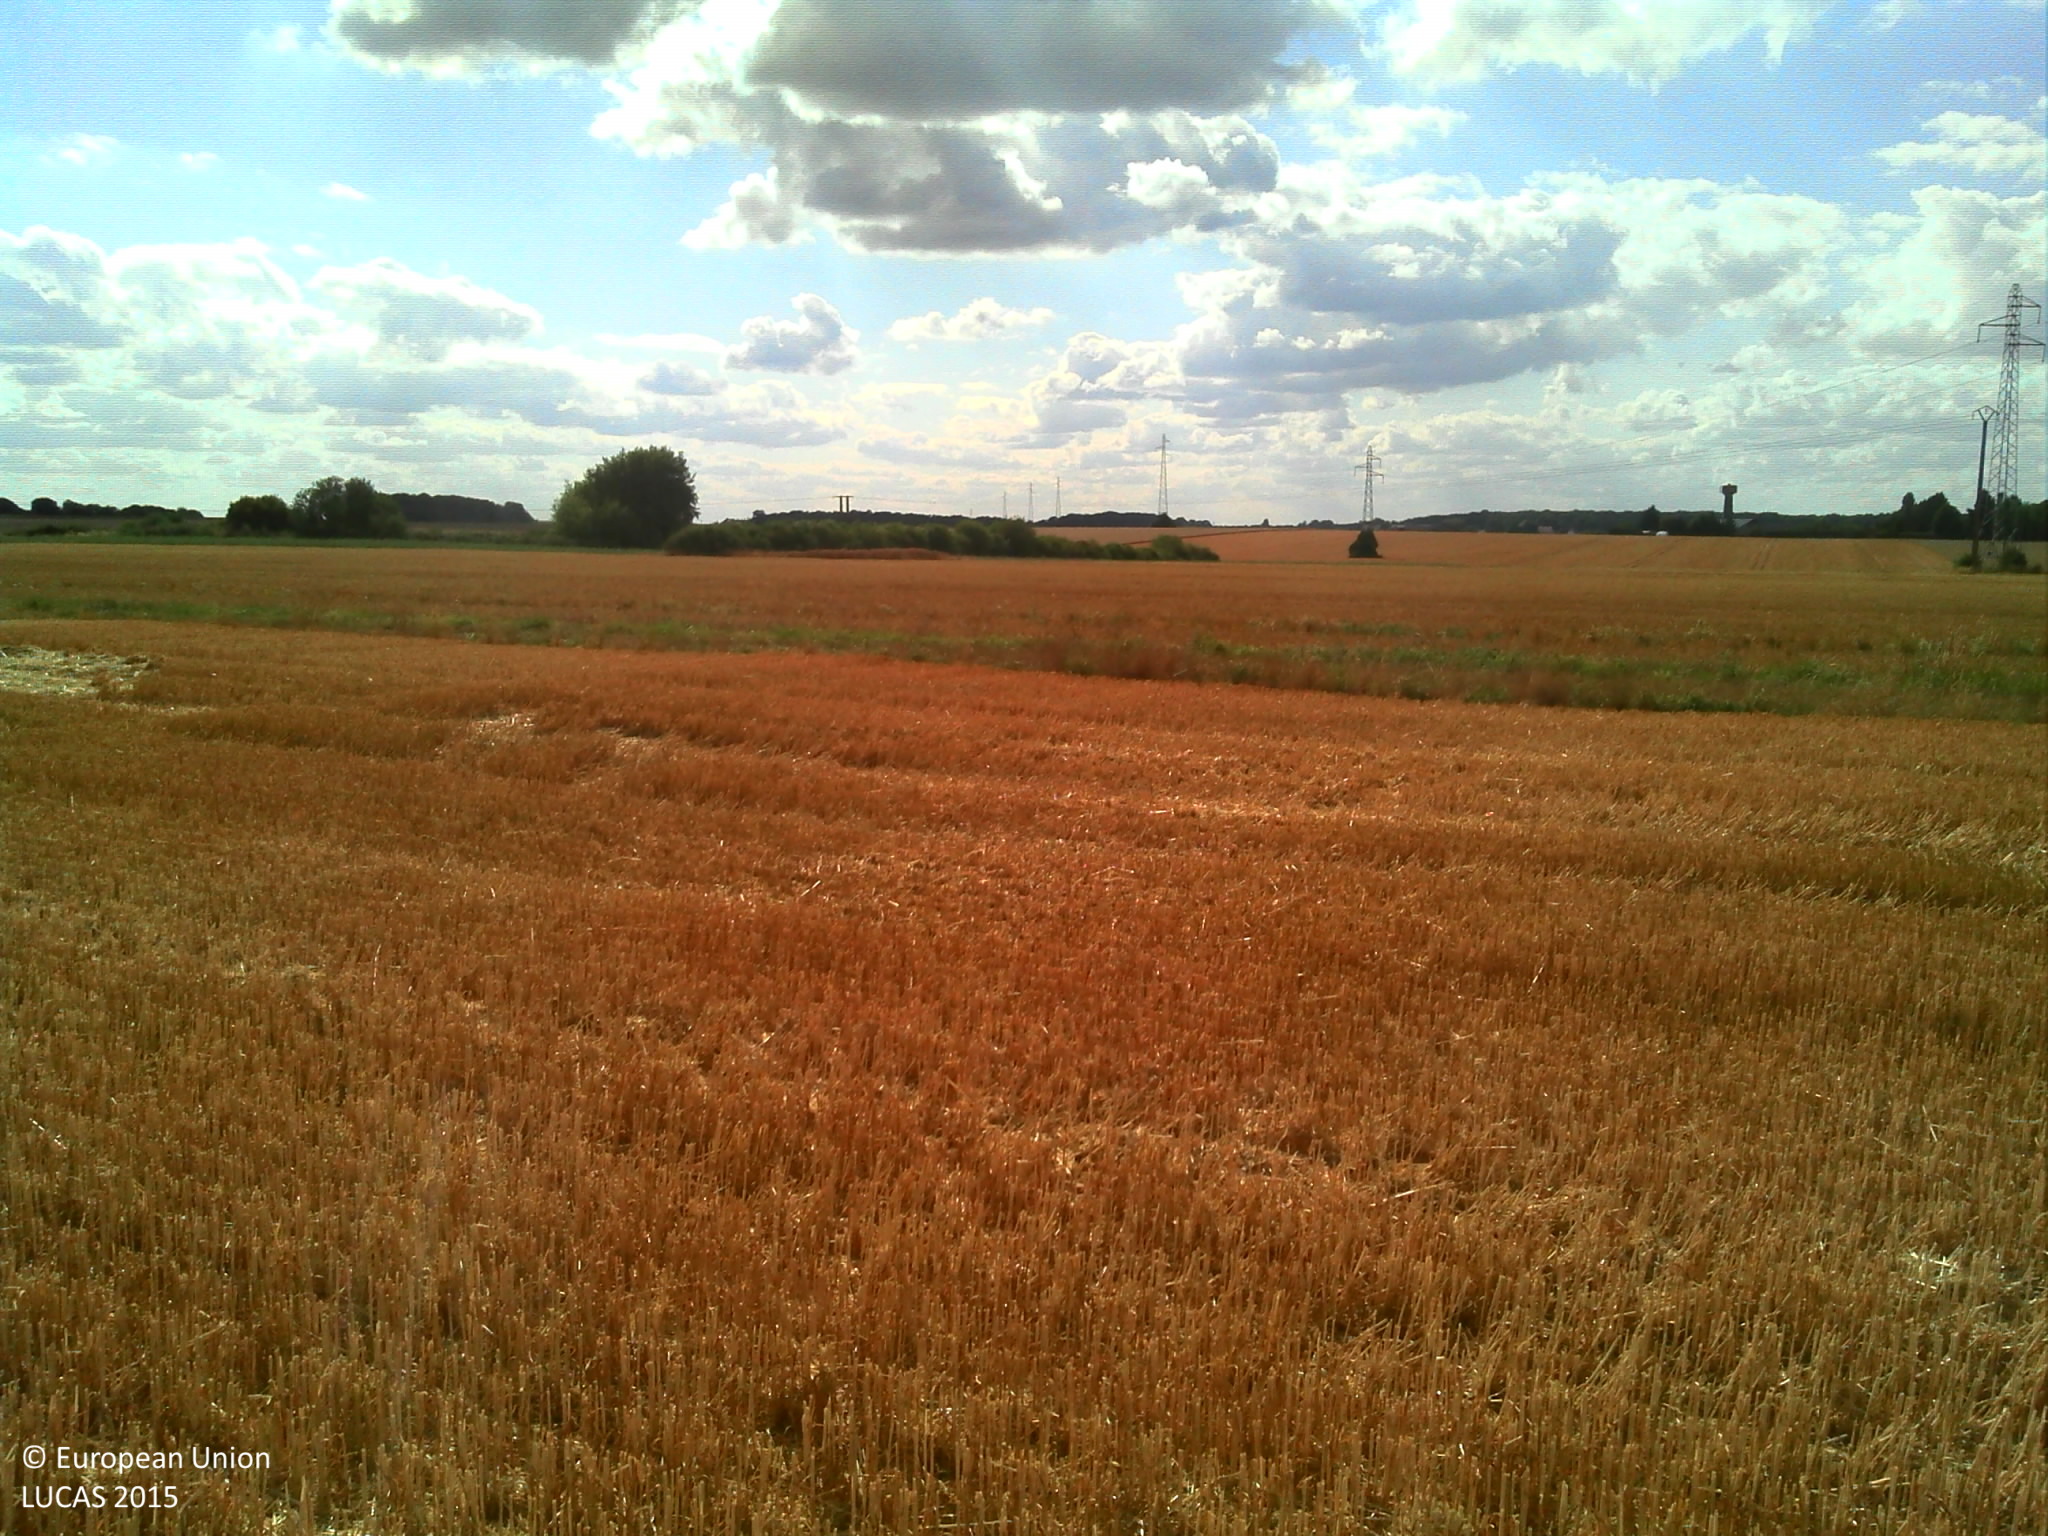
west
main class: Cropland
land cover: Common wheat
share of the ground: > 75 %
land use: Agriculture (excluding fallow land and kitchen gardens)
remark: Harvested field
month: July
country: FR
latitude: 48.5621
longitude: 1.2412
